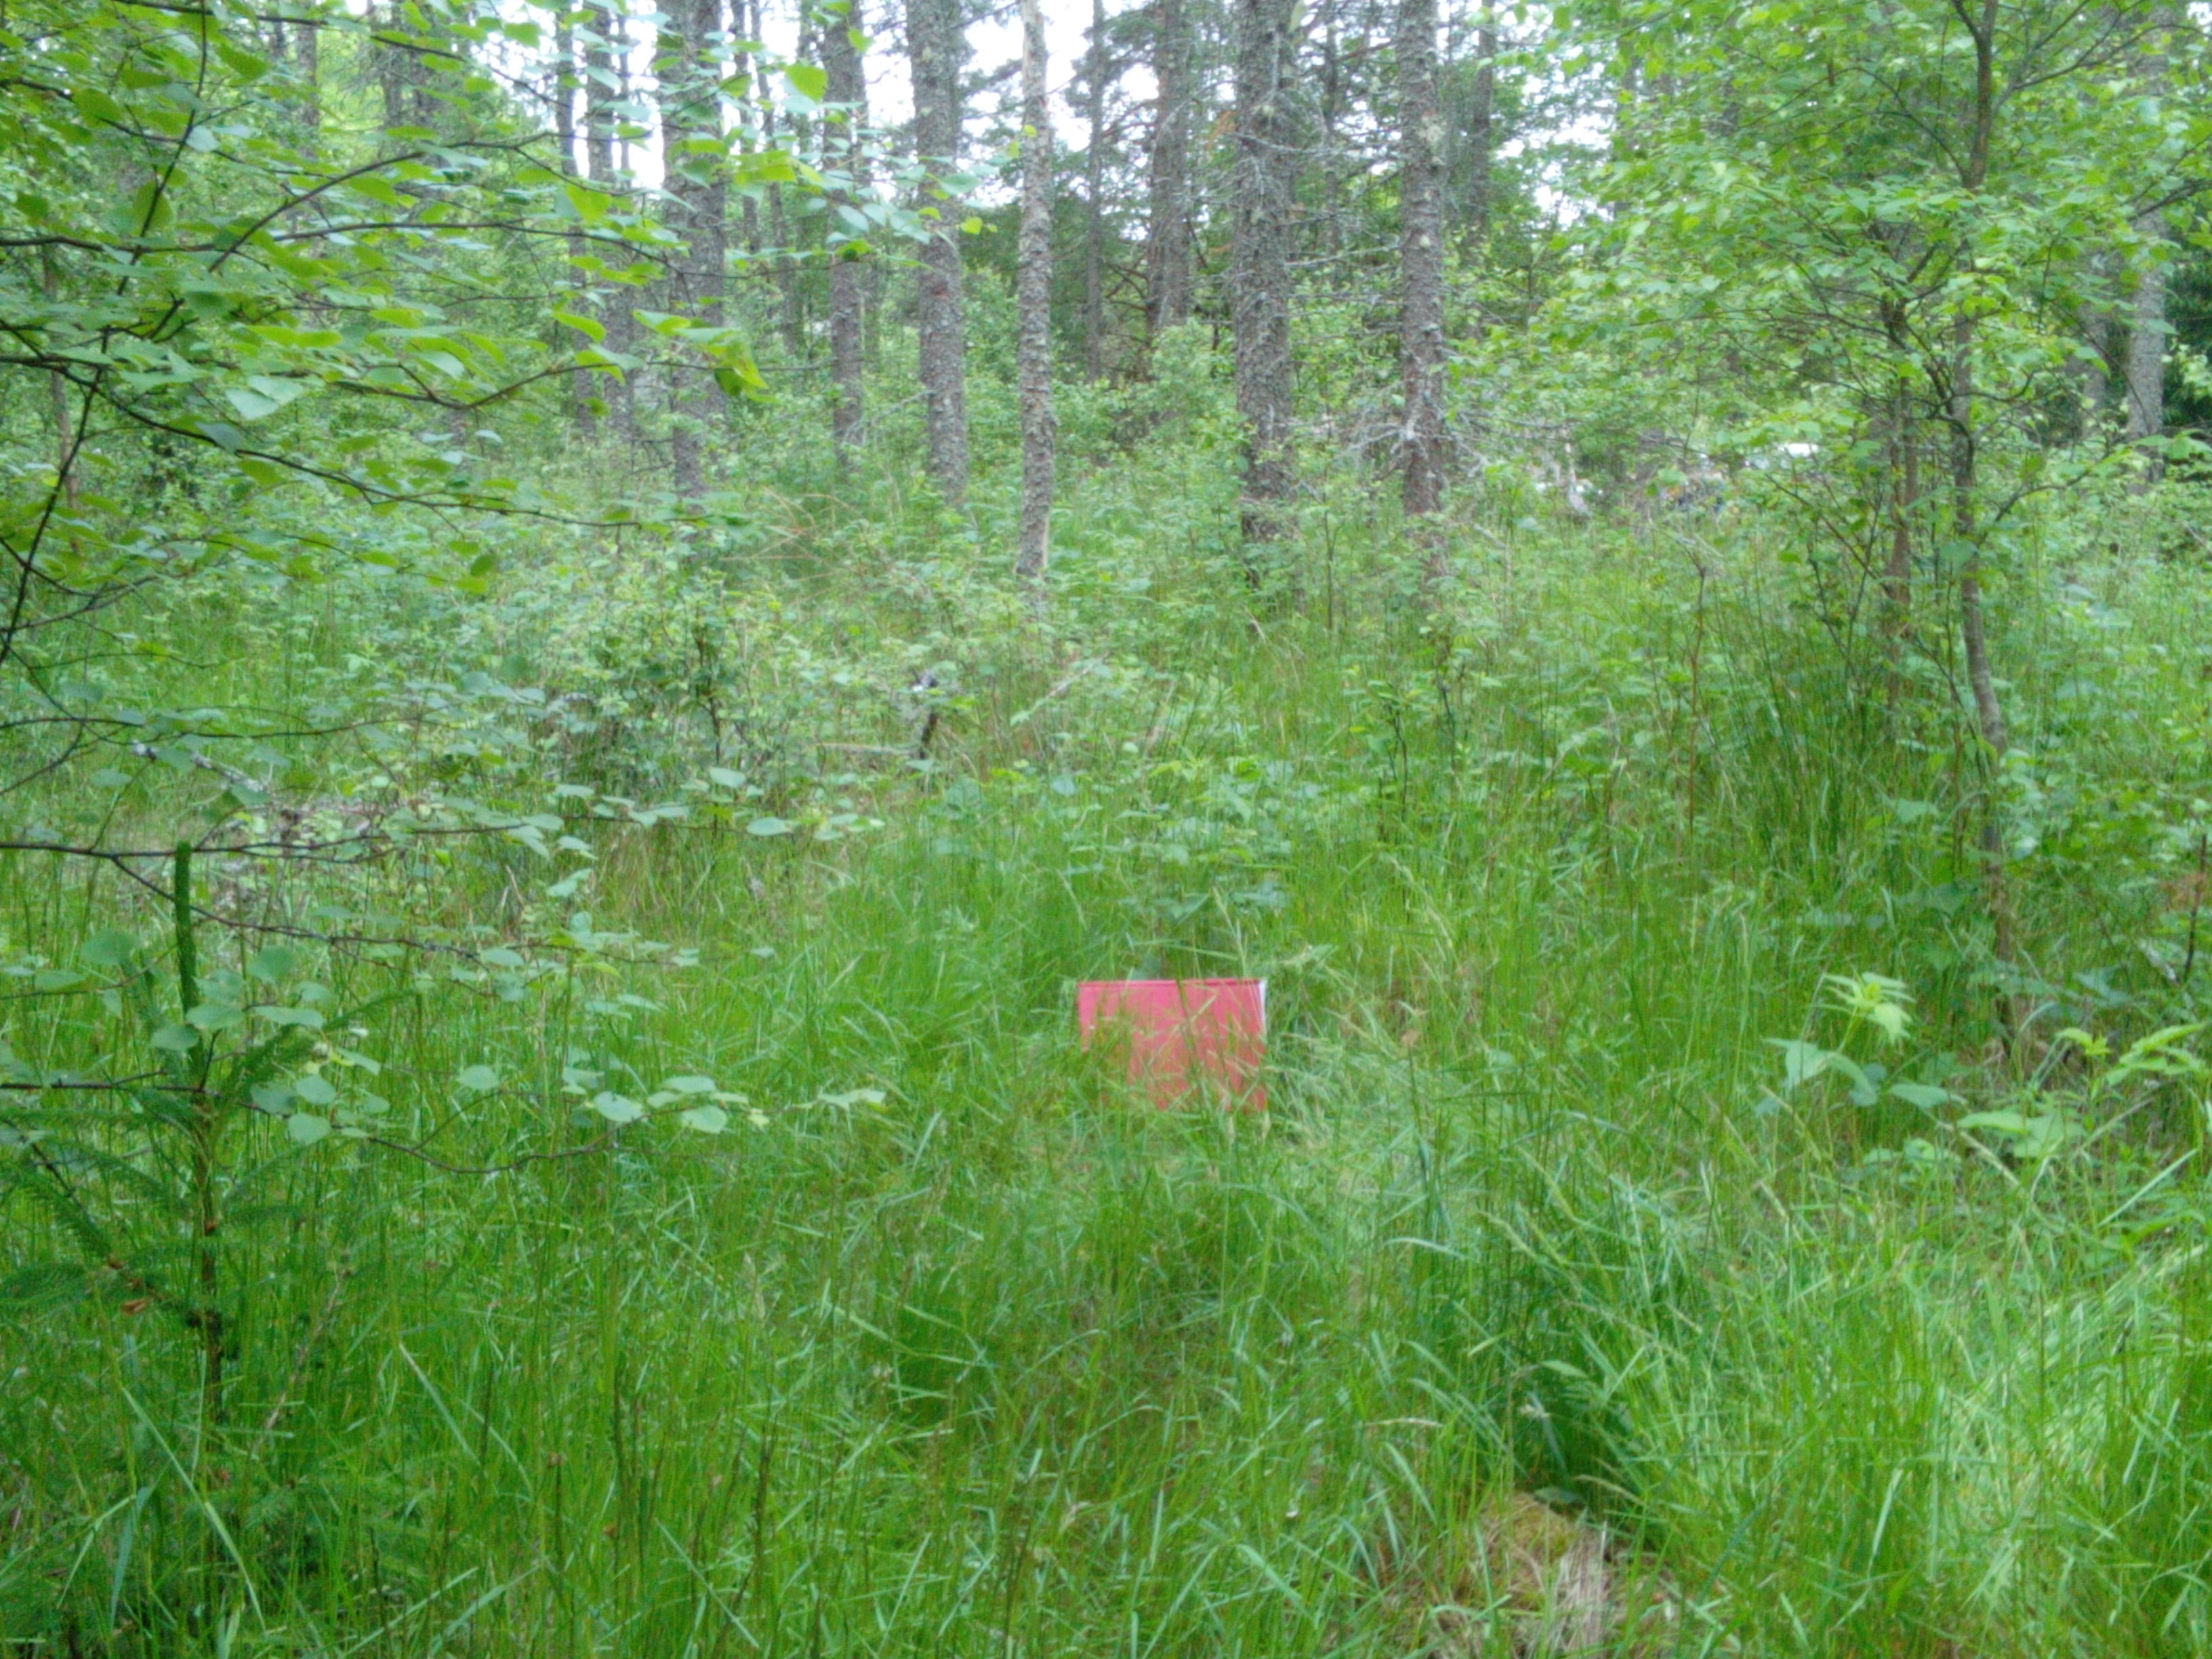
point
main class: Woodland
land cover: Spruce dominated mixed woodland
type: hemiboreal forest and nemoral coniferous forest and mixed broadleaved-coniferous forest
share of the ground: 50 - 75 %
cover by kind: broadleaved forest trees 45 %, coniferous forest trees 25 %, herbaceous plants 20 %, shrubs 10 %
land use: Forestry
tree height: > 5 m
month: June
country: LV
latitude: 56.9774
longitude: 21.5080
